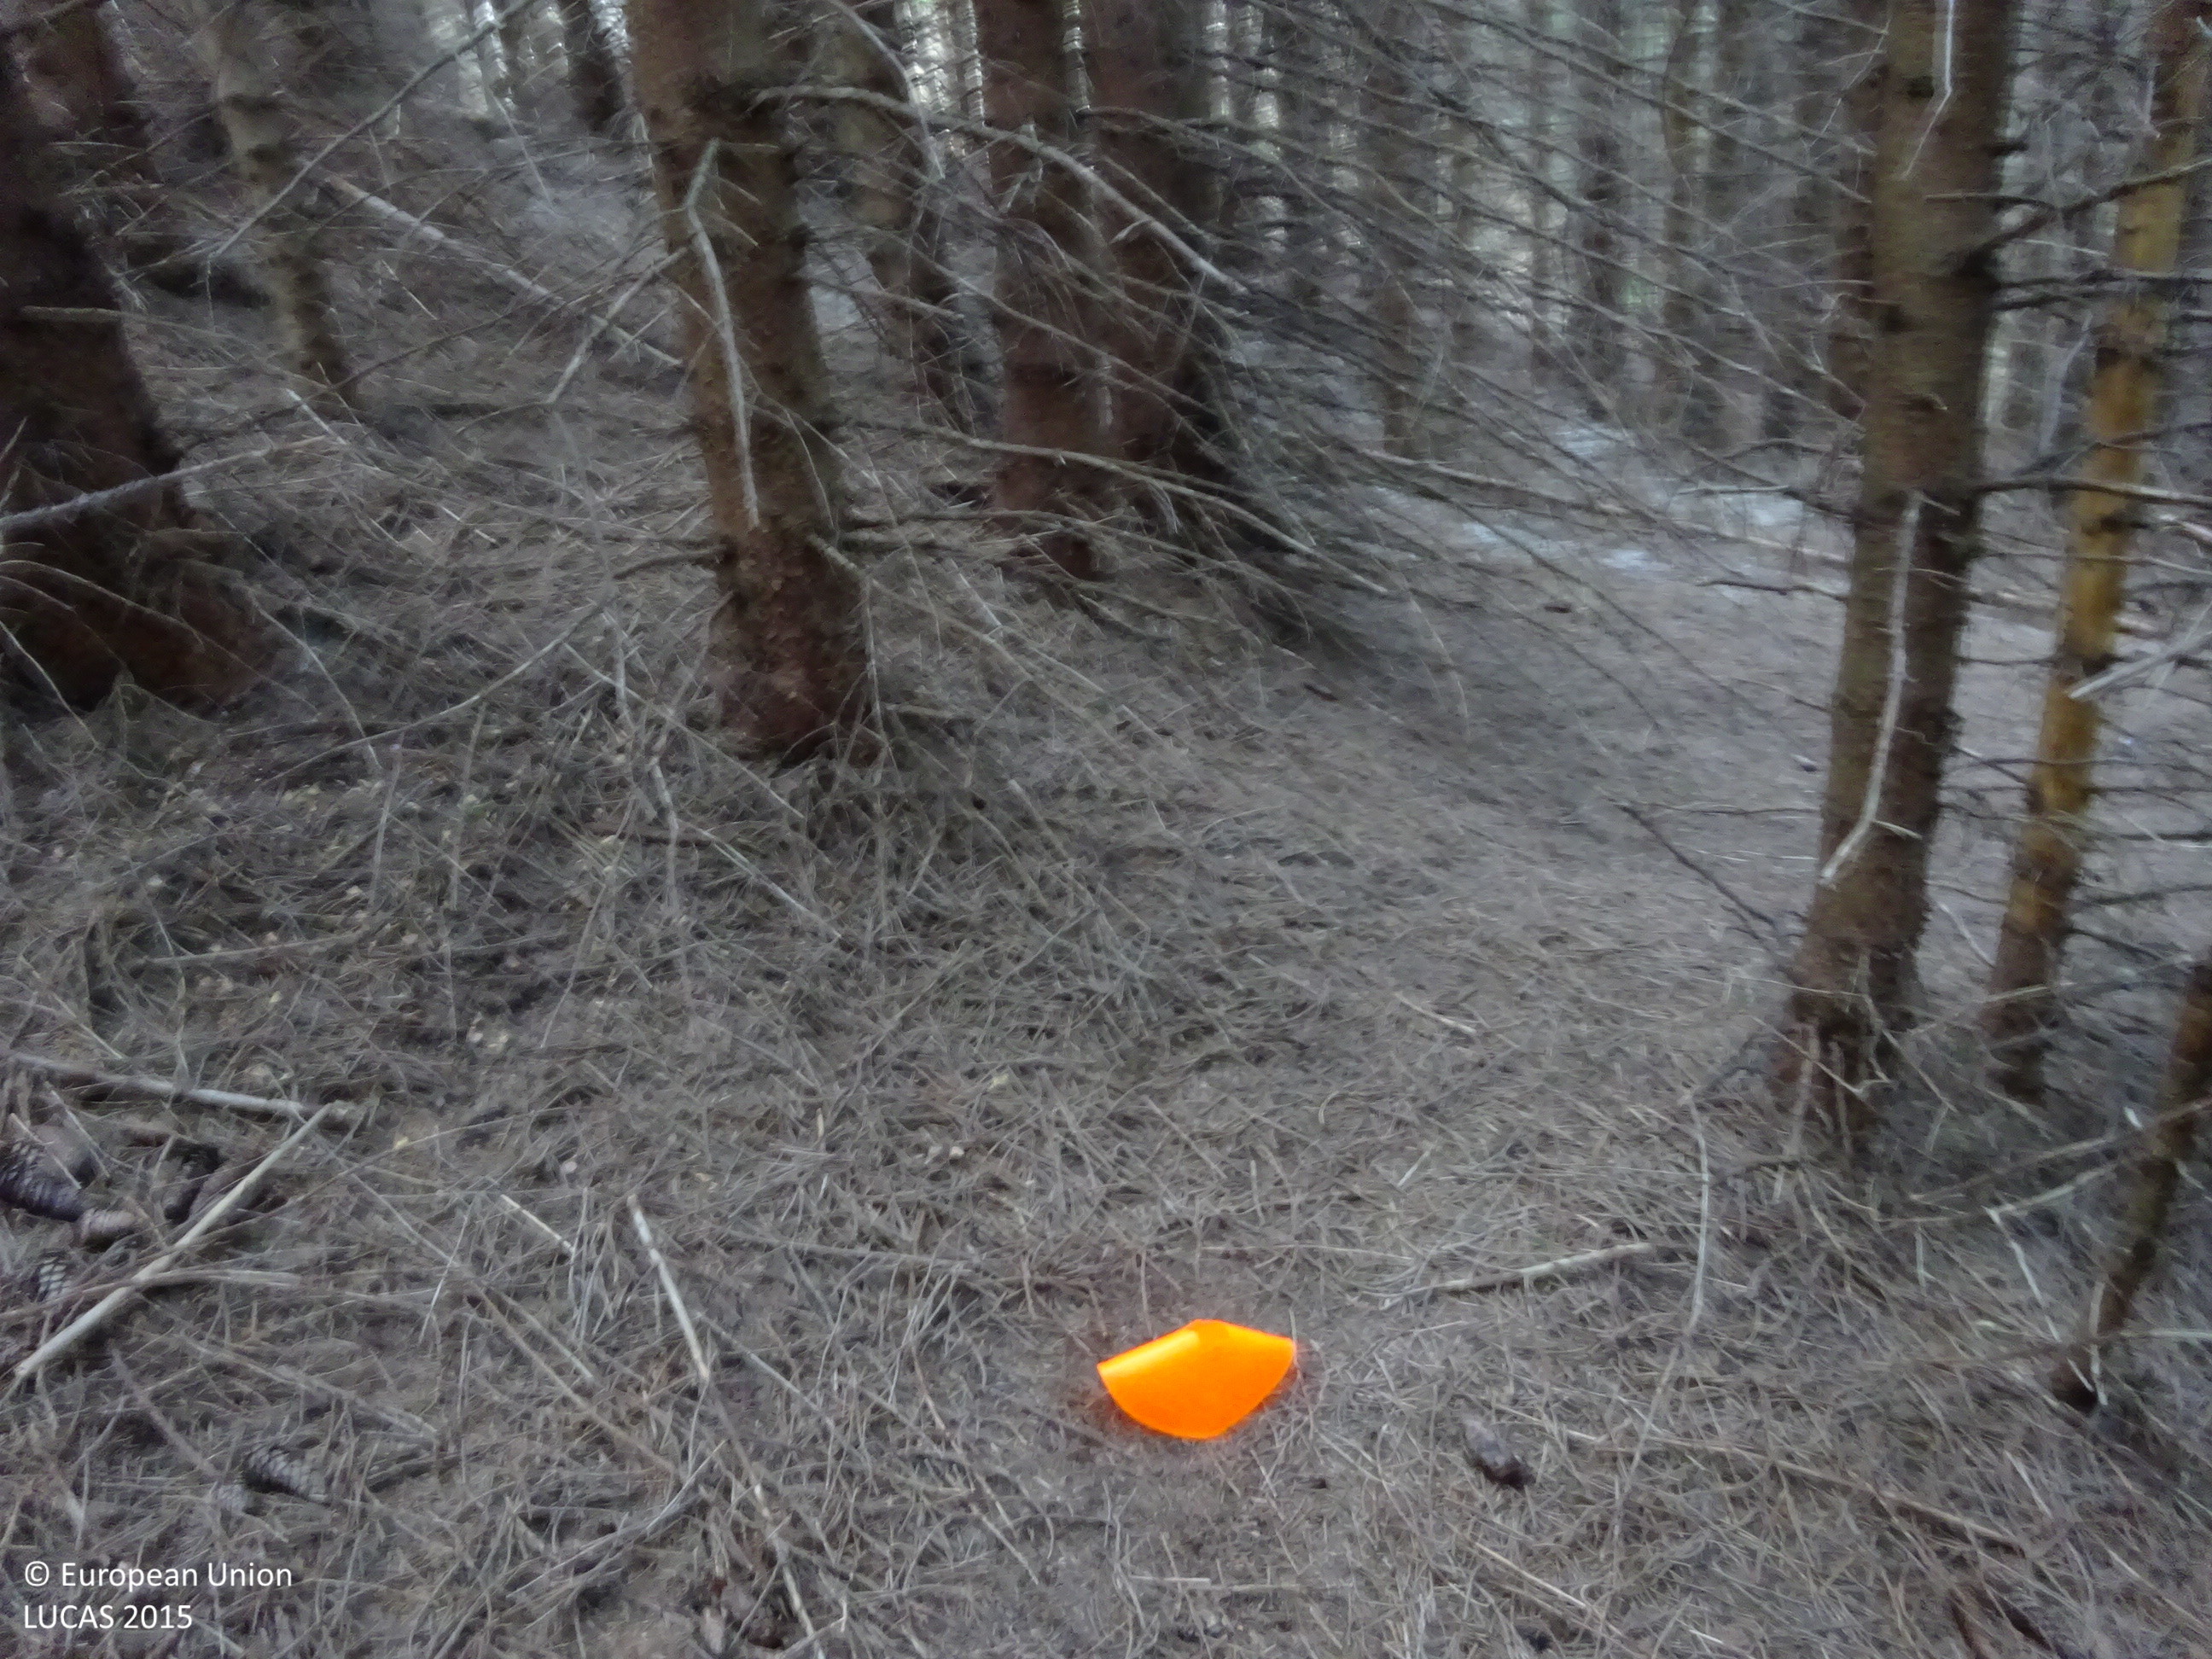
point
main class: Woodland
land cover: Spruce dominated coniferous woodland
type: alpine coniferous forest
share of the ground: > 75 %
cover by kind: coniferous forest trees 100 %
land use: Forestry
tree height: > 5 m
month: August
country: AT
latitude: 47.5551
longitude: 15.9957
